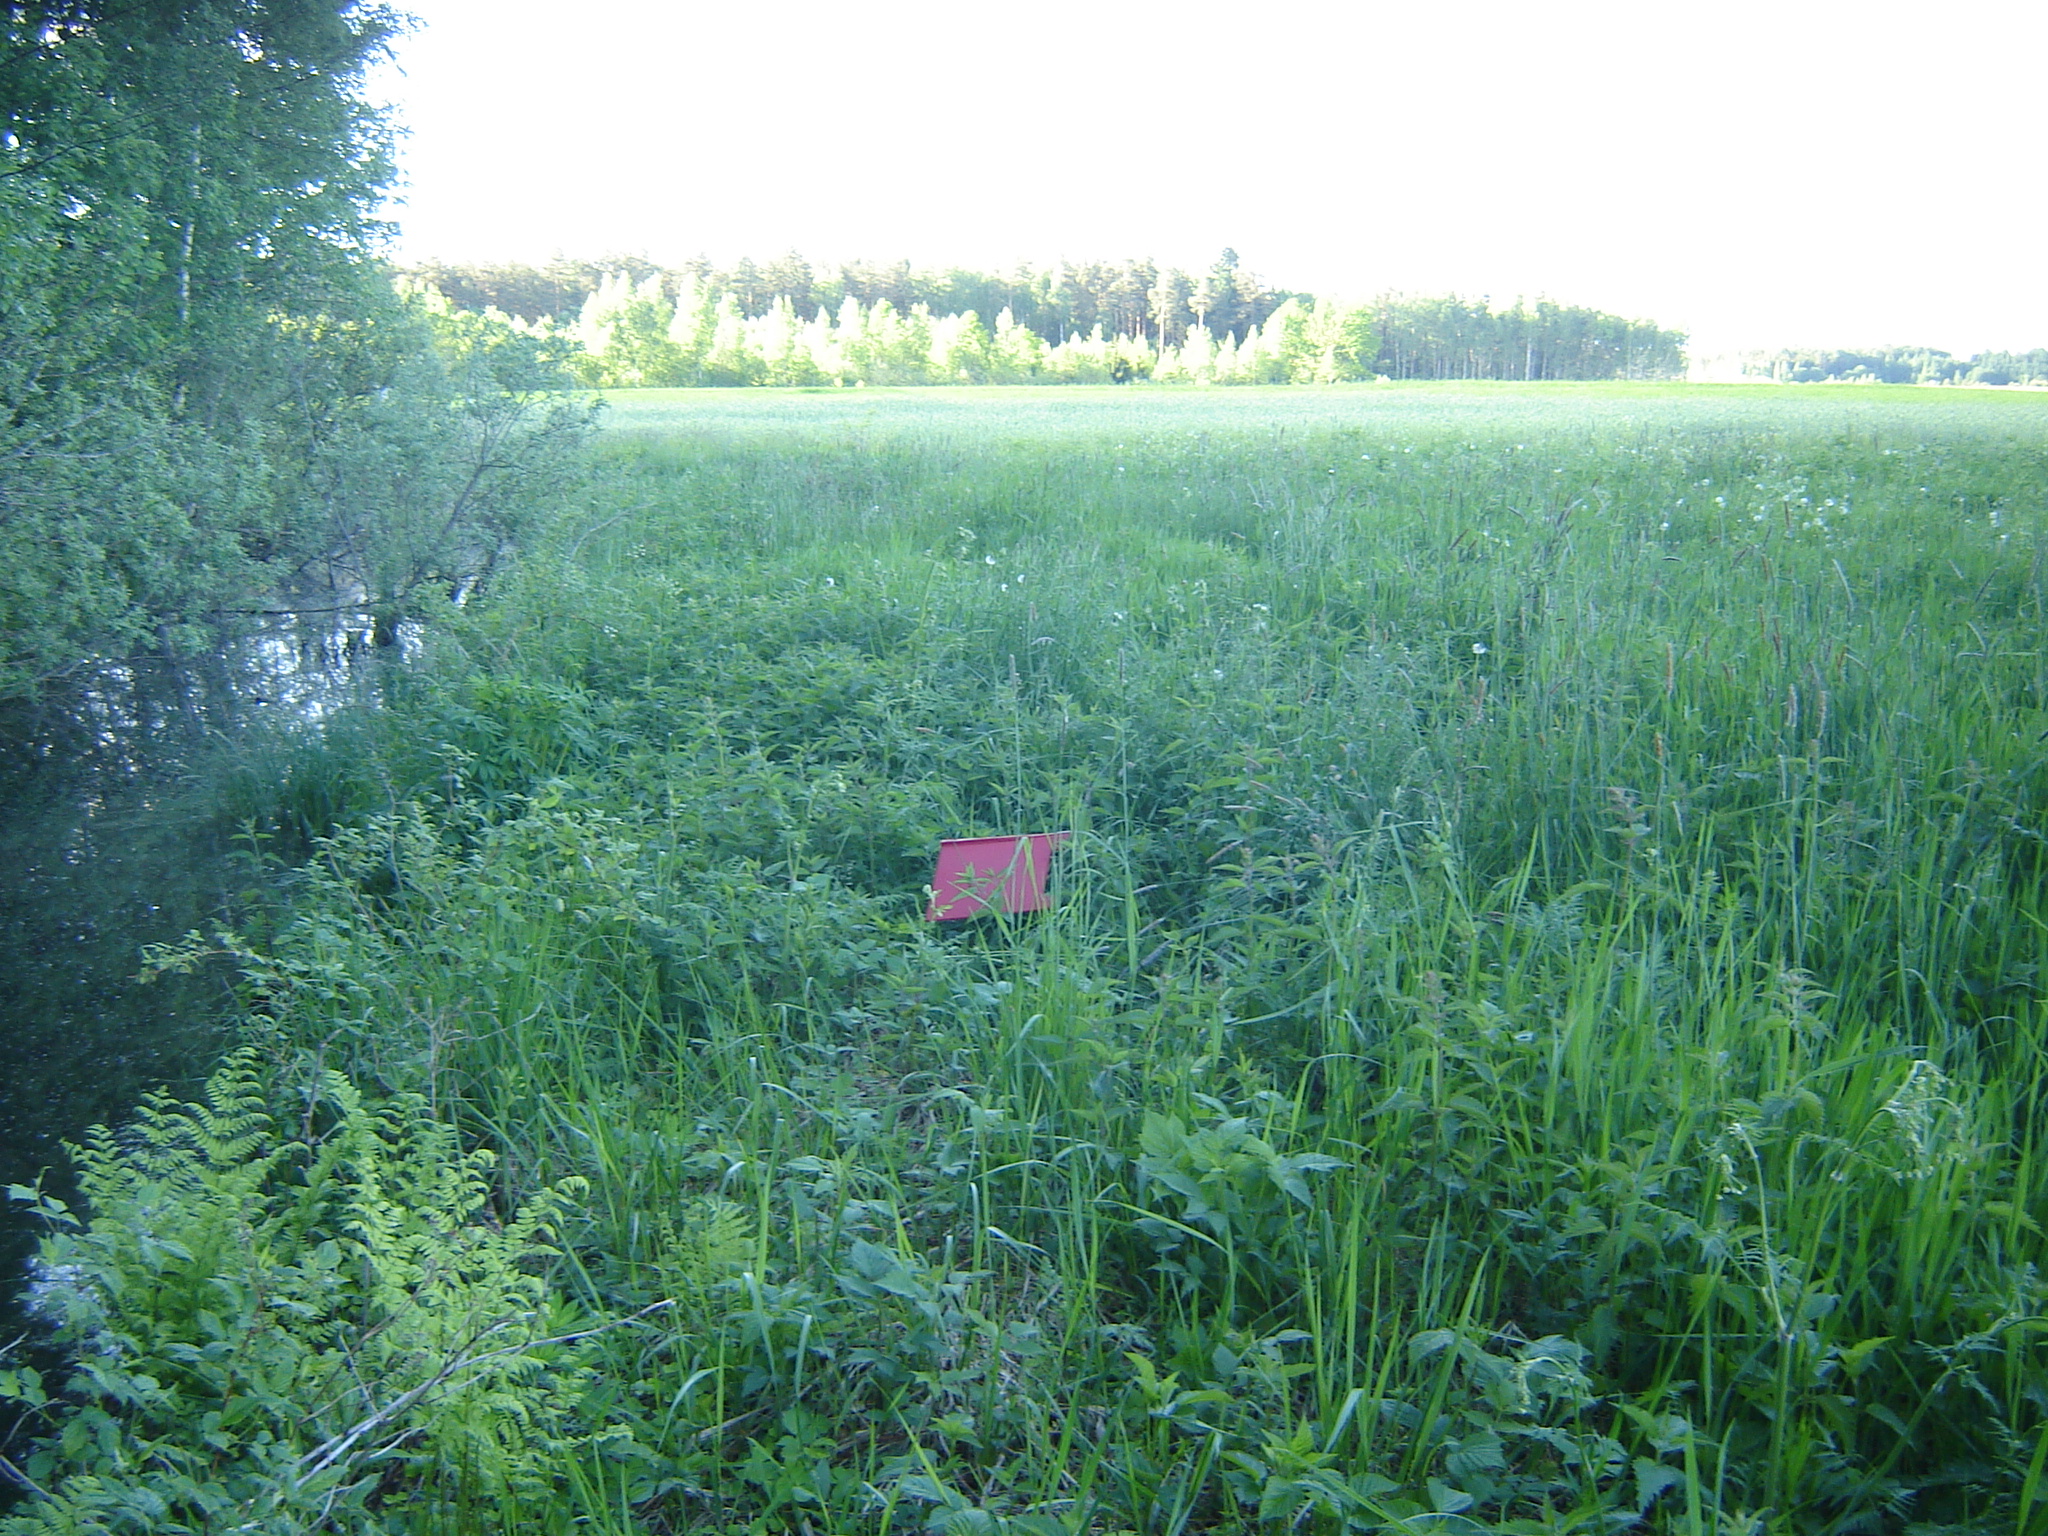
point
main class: Grassland
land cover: Spontaneously vegetated surfaces
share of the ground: > 75 %
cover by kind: herbaceous plants 100 %
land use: Fallow land
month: May
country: LT
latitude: 55.7645
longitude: 25.2418
